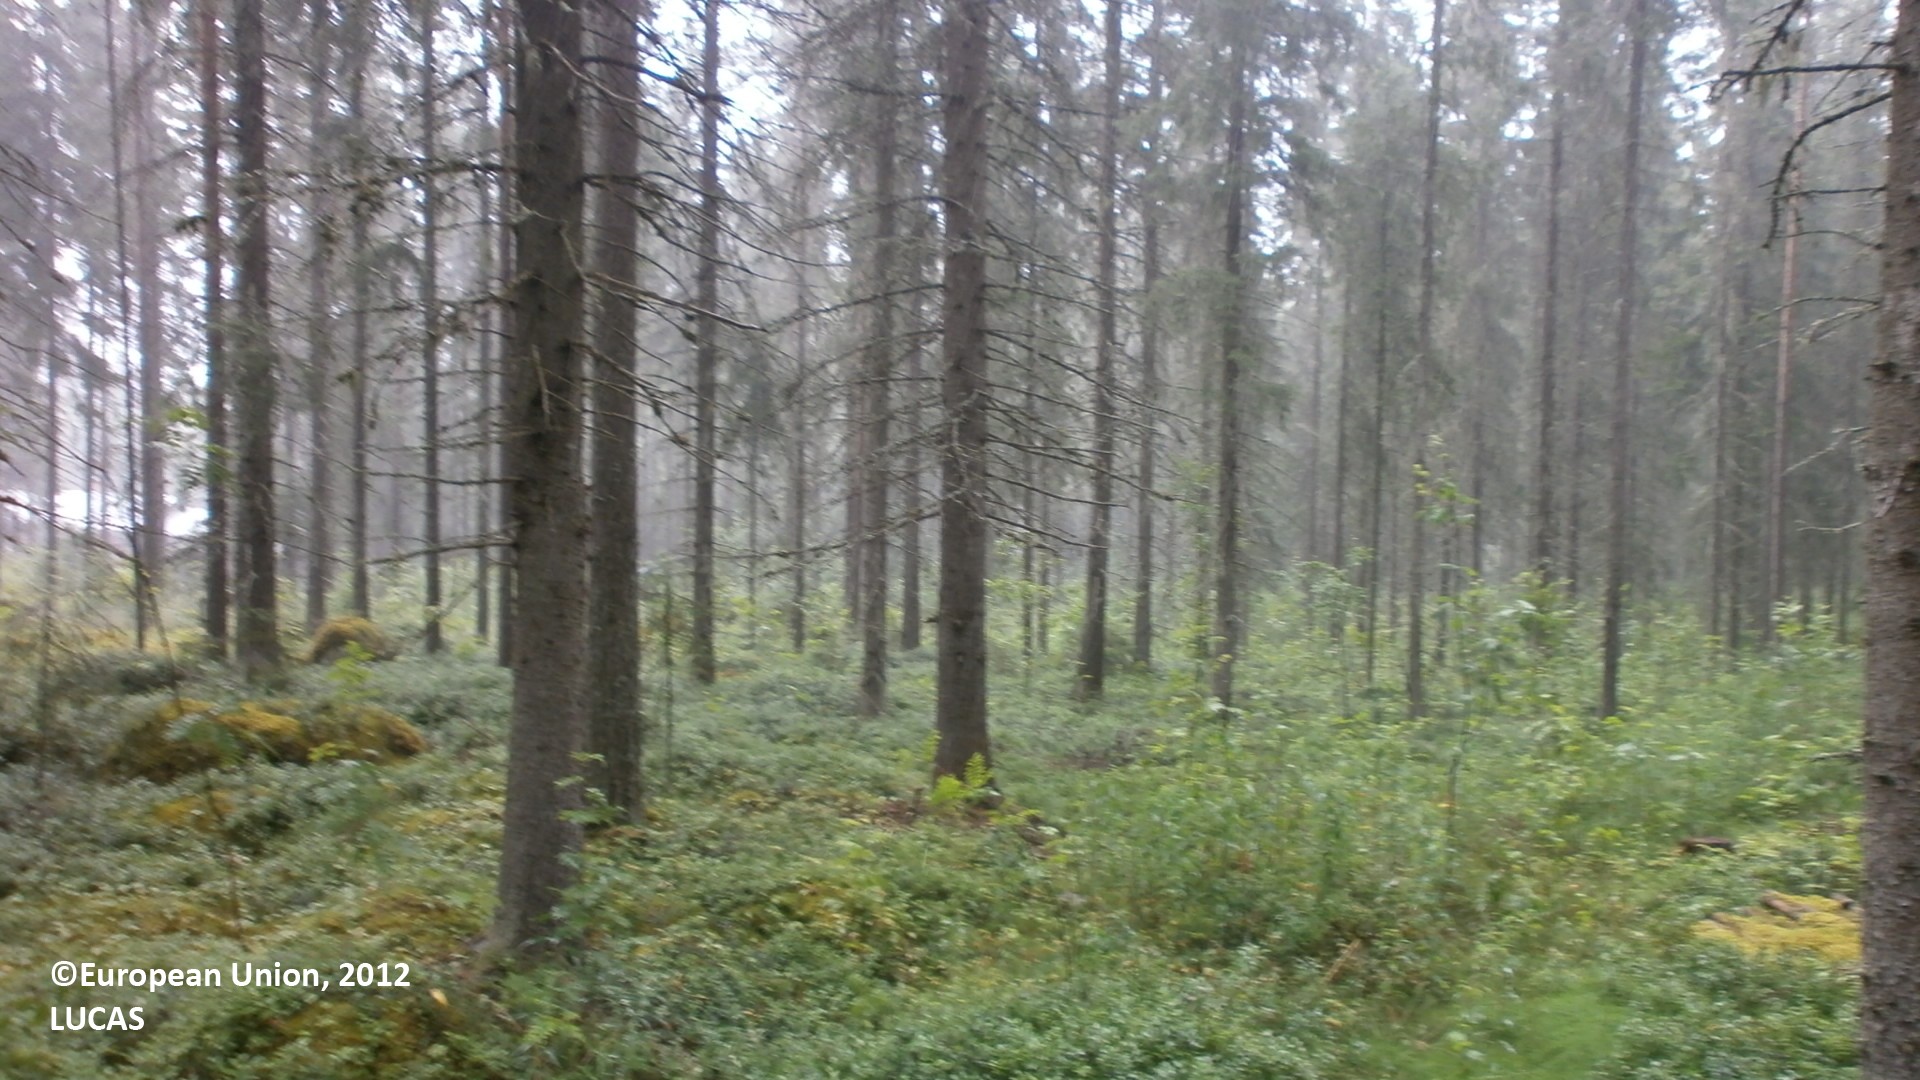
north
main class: Woodland
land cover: Spruce dominated coniferous woodland
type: boreal forest
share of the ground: 50 - 75 %
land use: Forestry
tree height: > 5 m
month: July
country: FI
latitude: 64.0874
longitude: 23.7819
